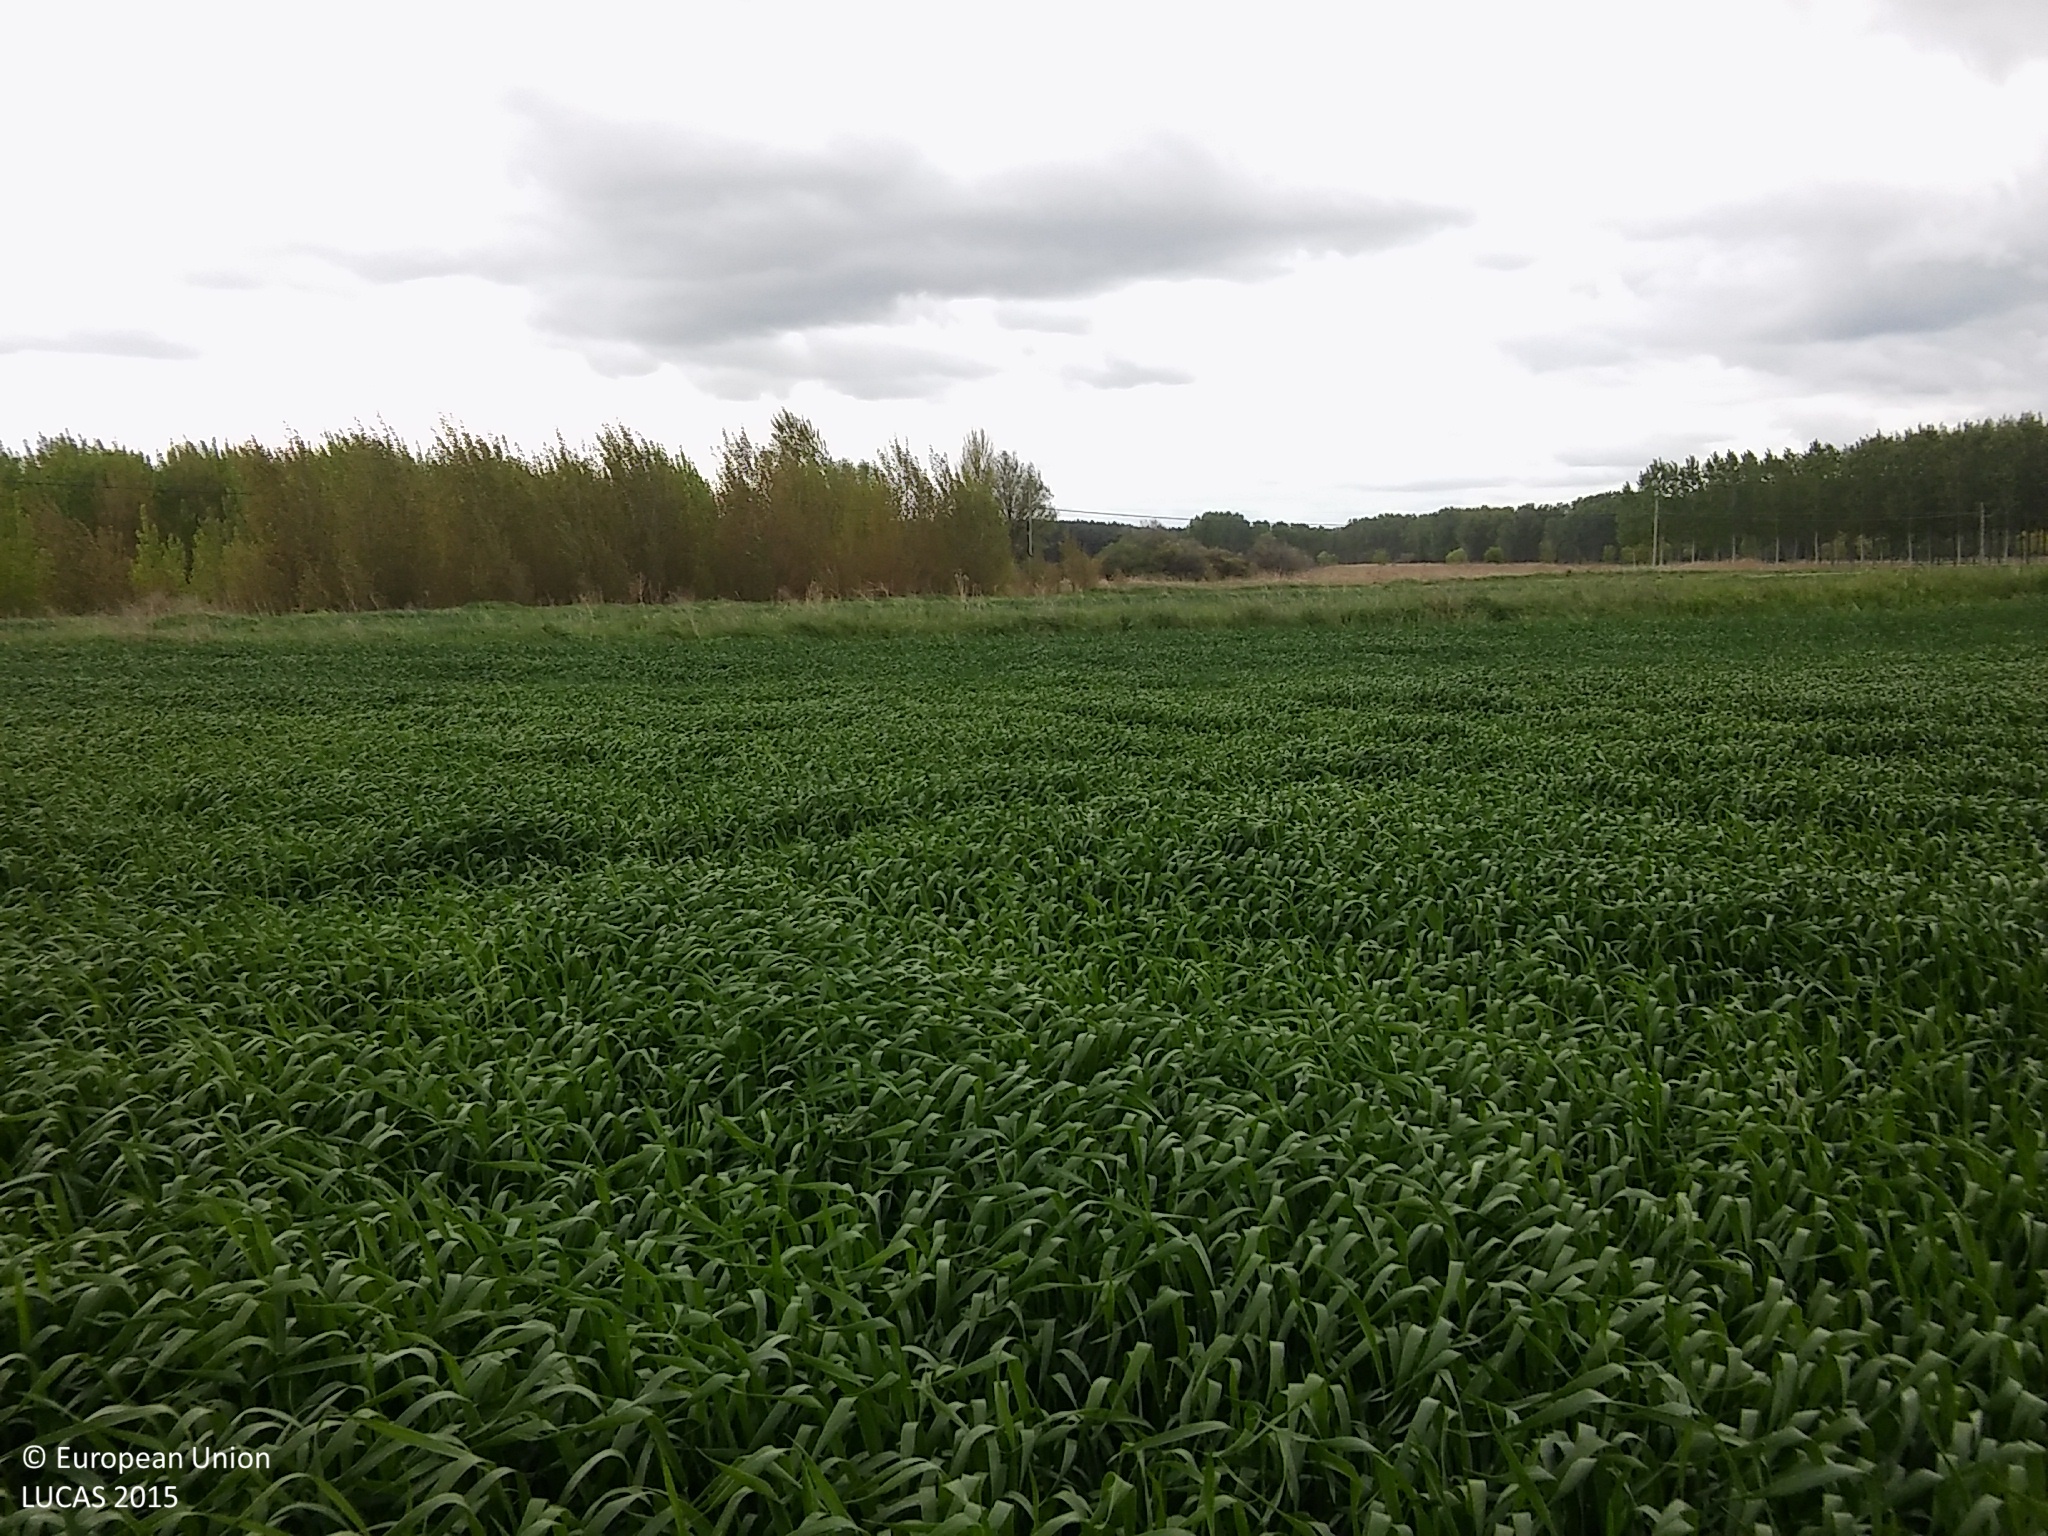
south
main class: Cropland
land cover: Barley
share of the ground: > 75 %
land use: Agriculture (excluding fallow land and kitchen gardens)
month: May
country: ES
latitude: 41.3888
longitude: -3.9618
